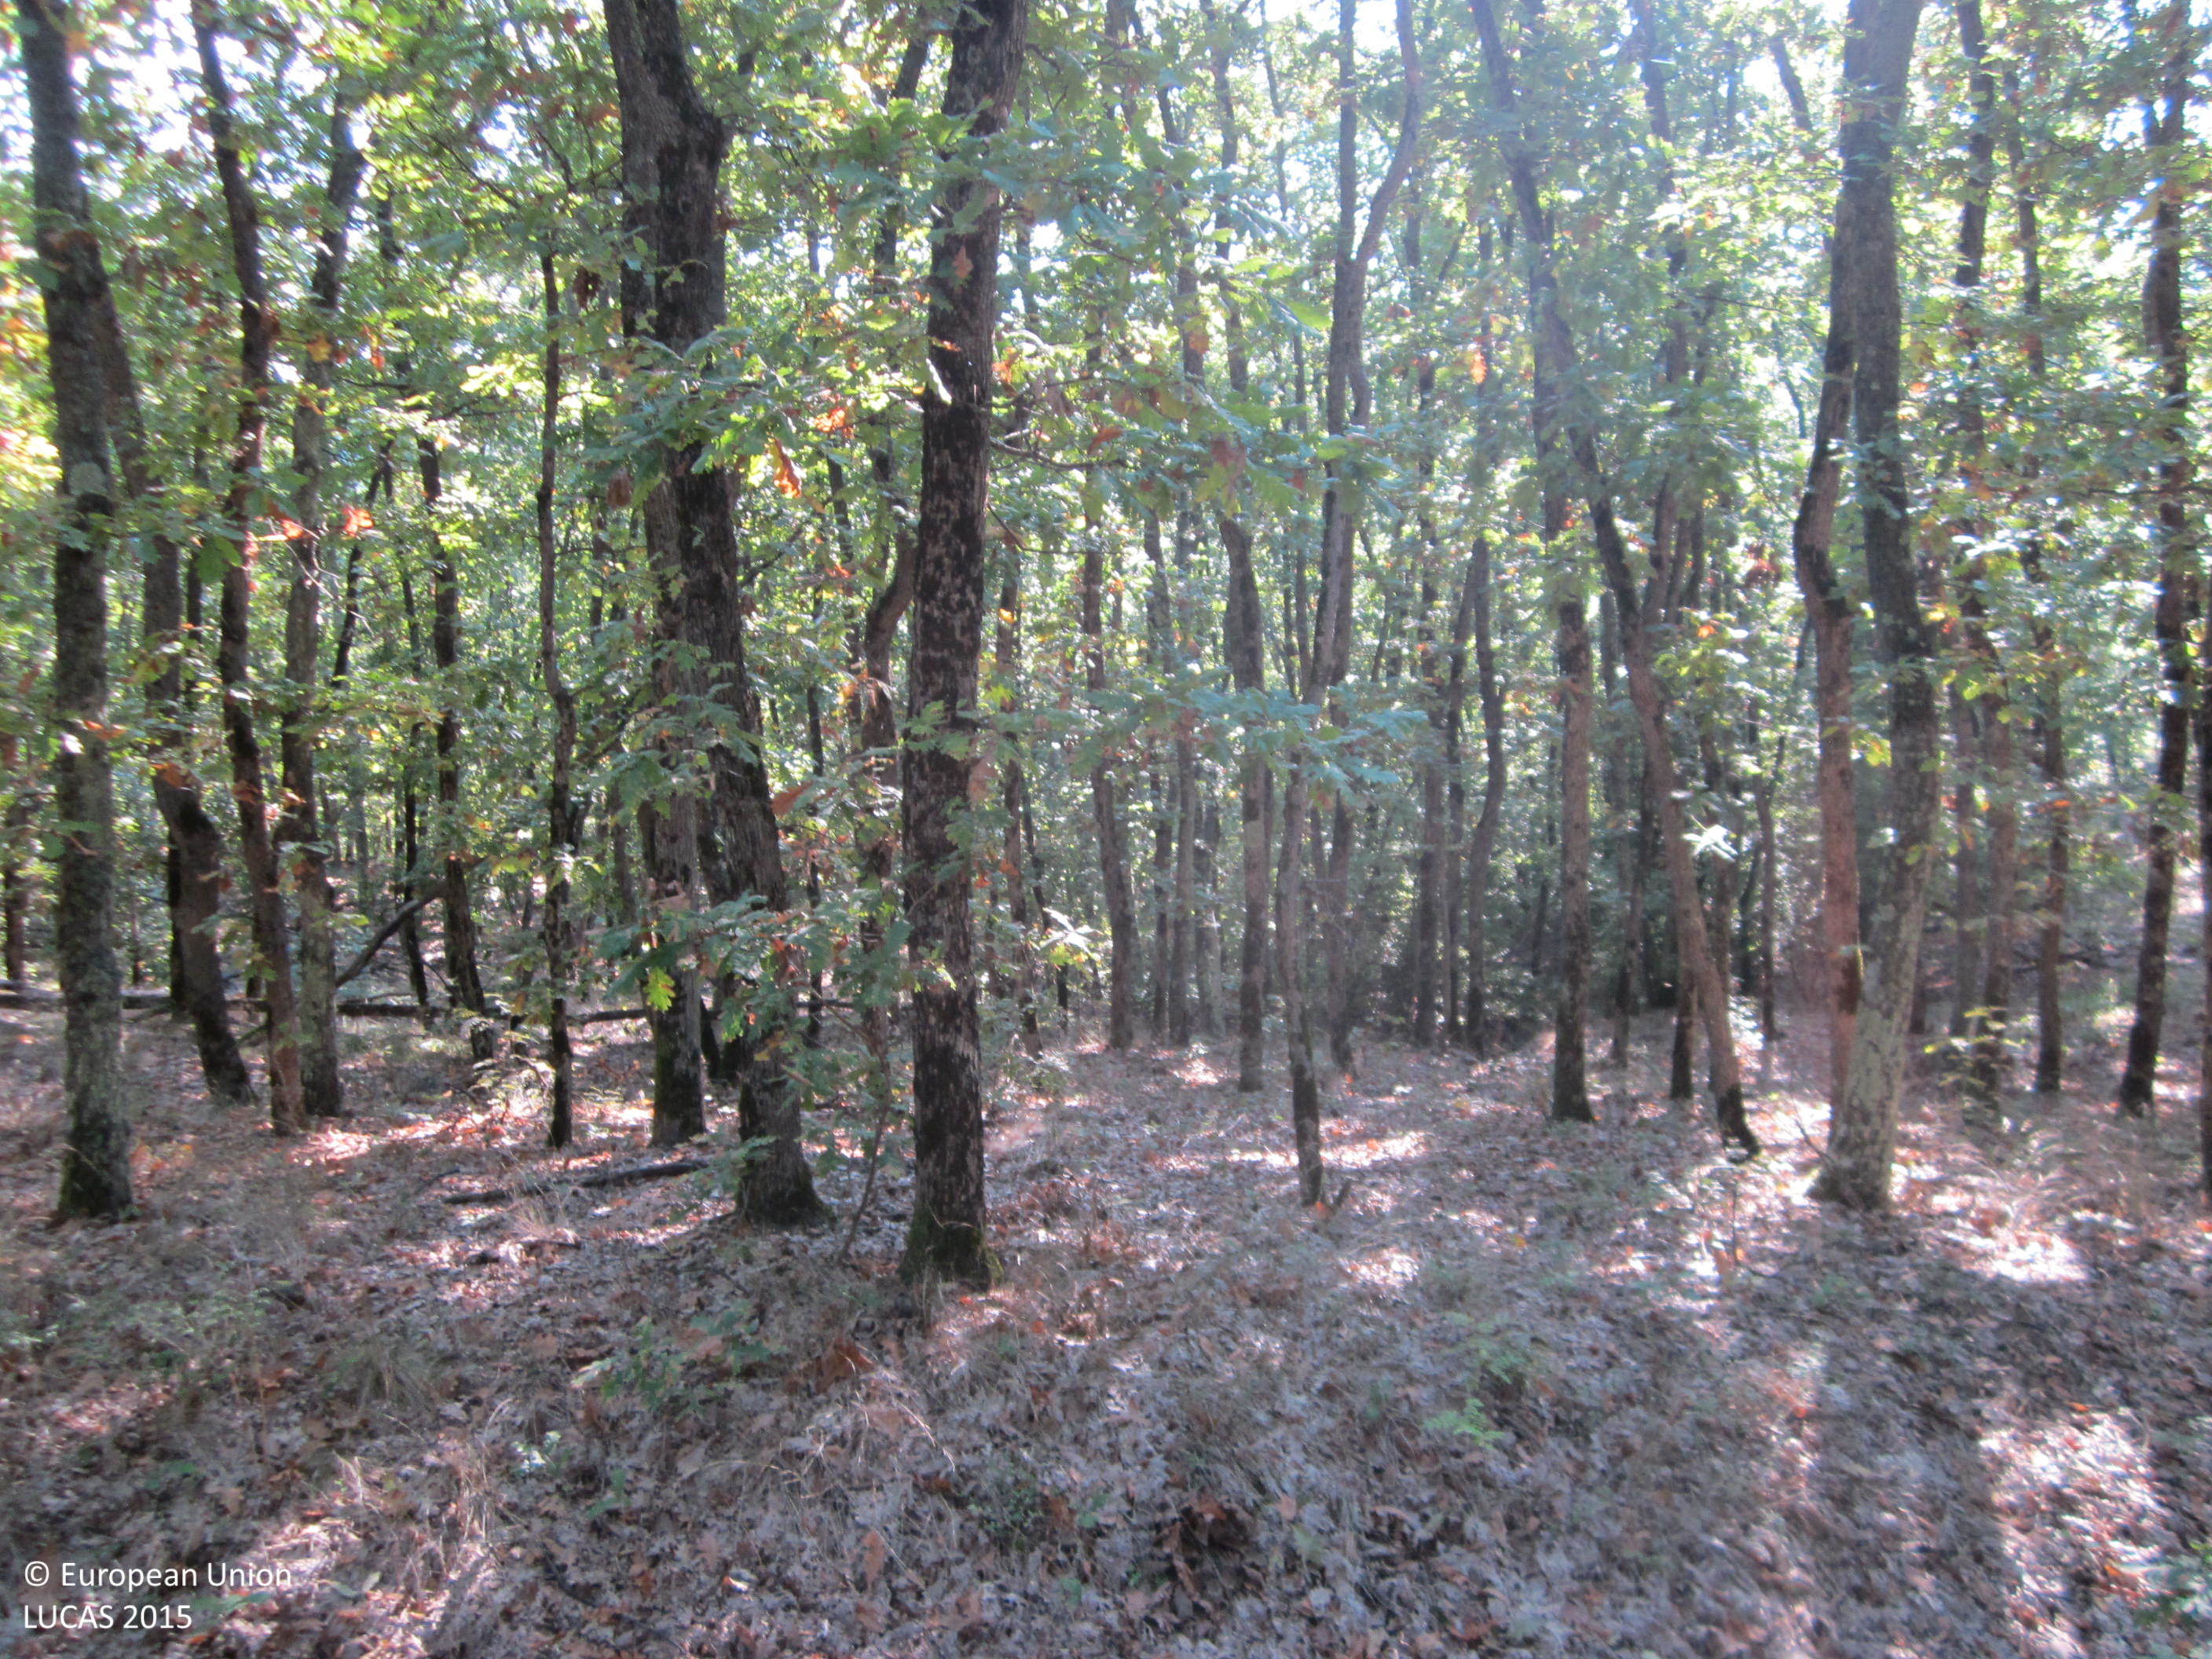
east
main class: Woodland
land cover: Broadleaved woodland
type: acidophilous oak and oak-birch forest
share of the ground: 50 - 75 %
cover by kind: broadleaved forest trees 70 %, unconsolidated bare surface 25 %, herbaceous plants 5 %
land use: Forestry
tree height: > 5 m
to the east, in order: Broadleaved woodland; Tracks; Broadleaved woodland; Rivers and streams; Broadleaved woodland; Rivers and streams; Broadleaved woodland; Rivers and streams; Broadleaved woodland; Inland fresh water bodies; Broadleaved woodland
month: October
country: BG
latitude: 42.7891
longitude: 26.6649
